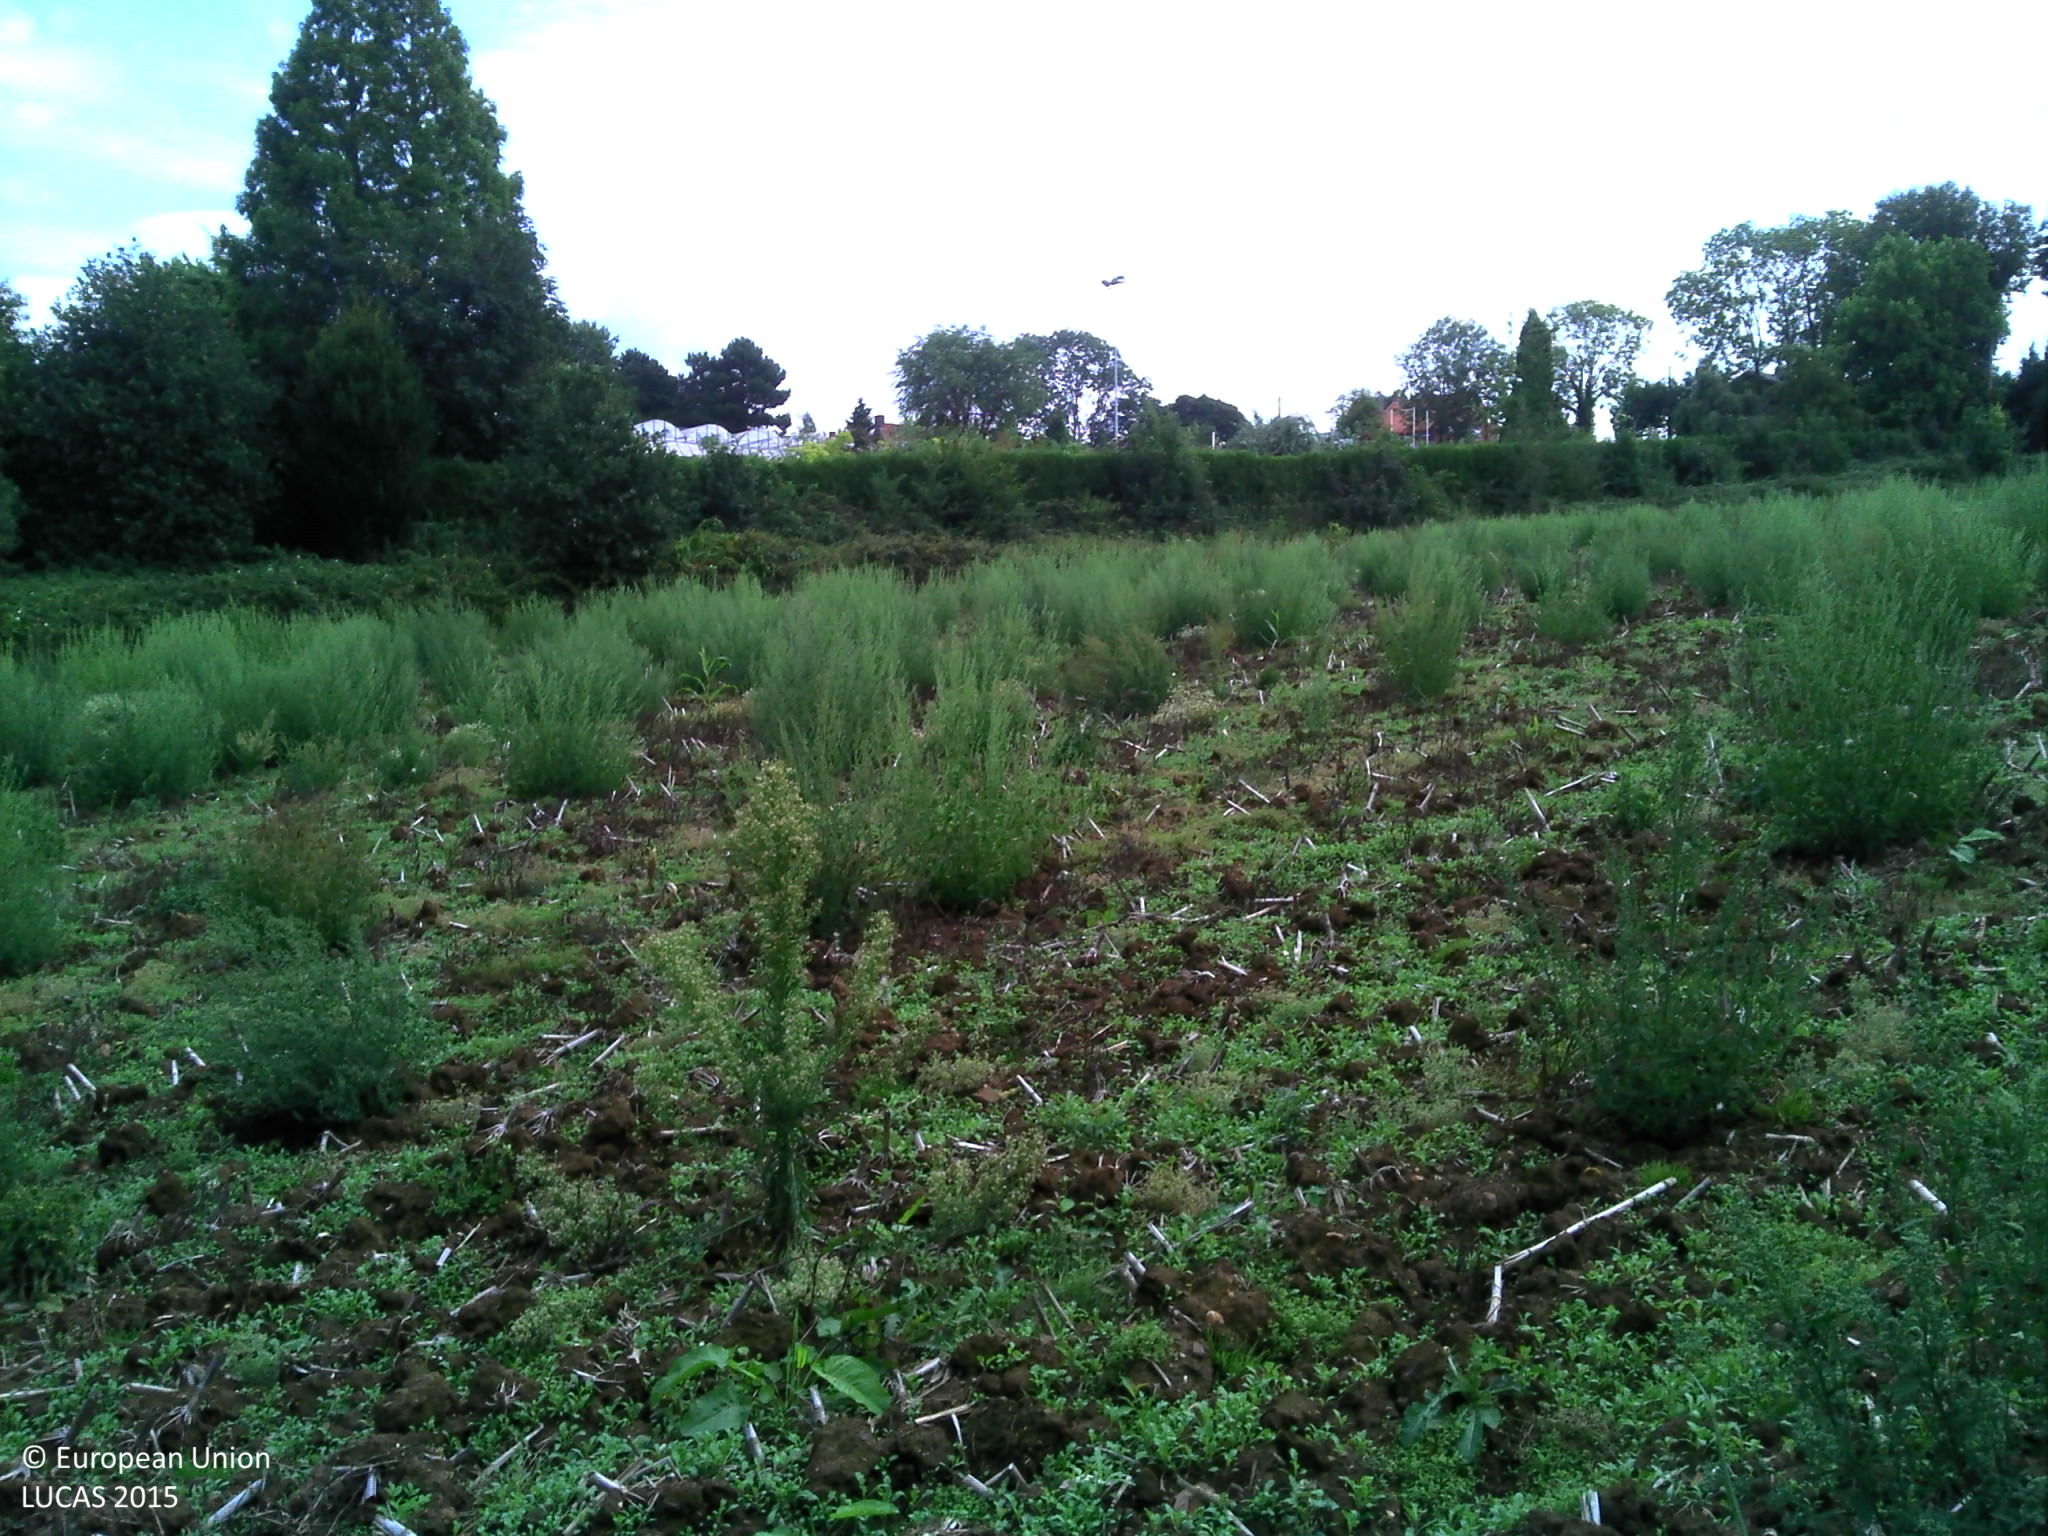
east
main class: Grassland
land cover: Spontaneously vegetated surfaces
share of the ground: > 75 %
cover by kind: herbaceous plants 50 %, unconsolidated bare surface 50 %
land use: Fallow land
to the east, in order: Spontaneously vegetated surfaces; Artificial constructions in urban areas; Broadleaved woodland; Artificial constructions in urban areas
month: August
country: BE
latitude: 50.7832
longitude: 2.7408
